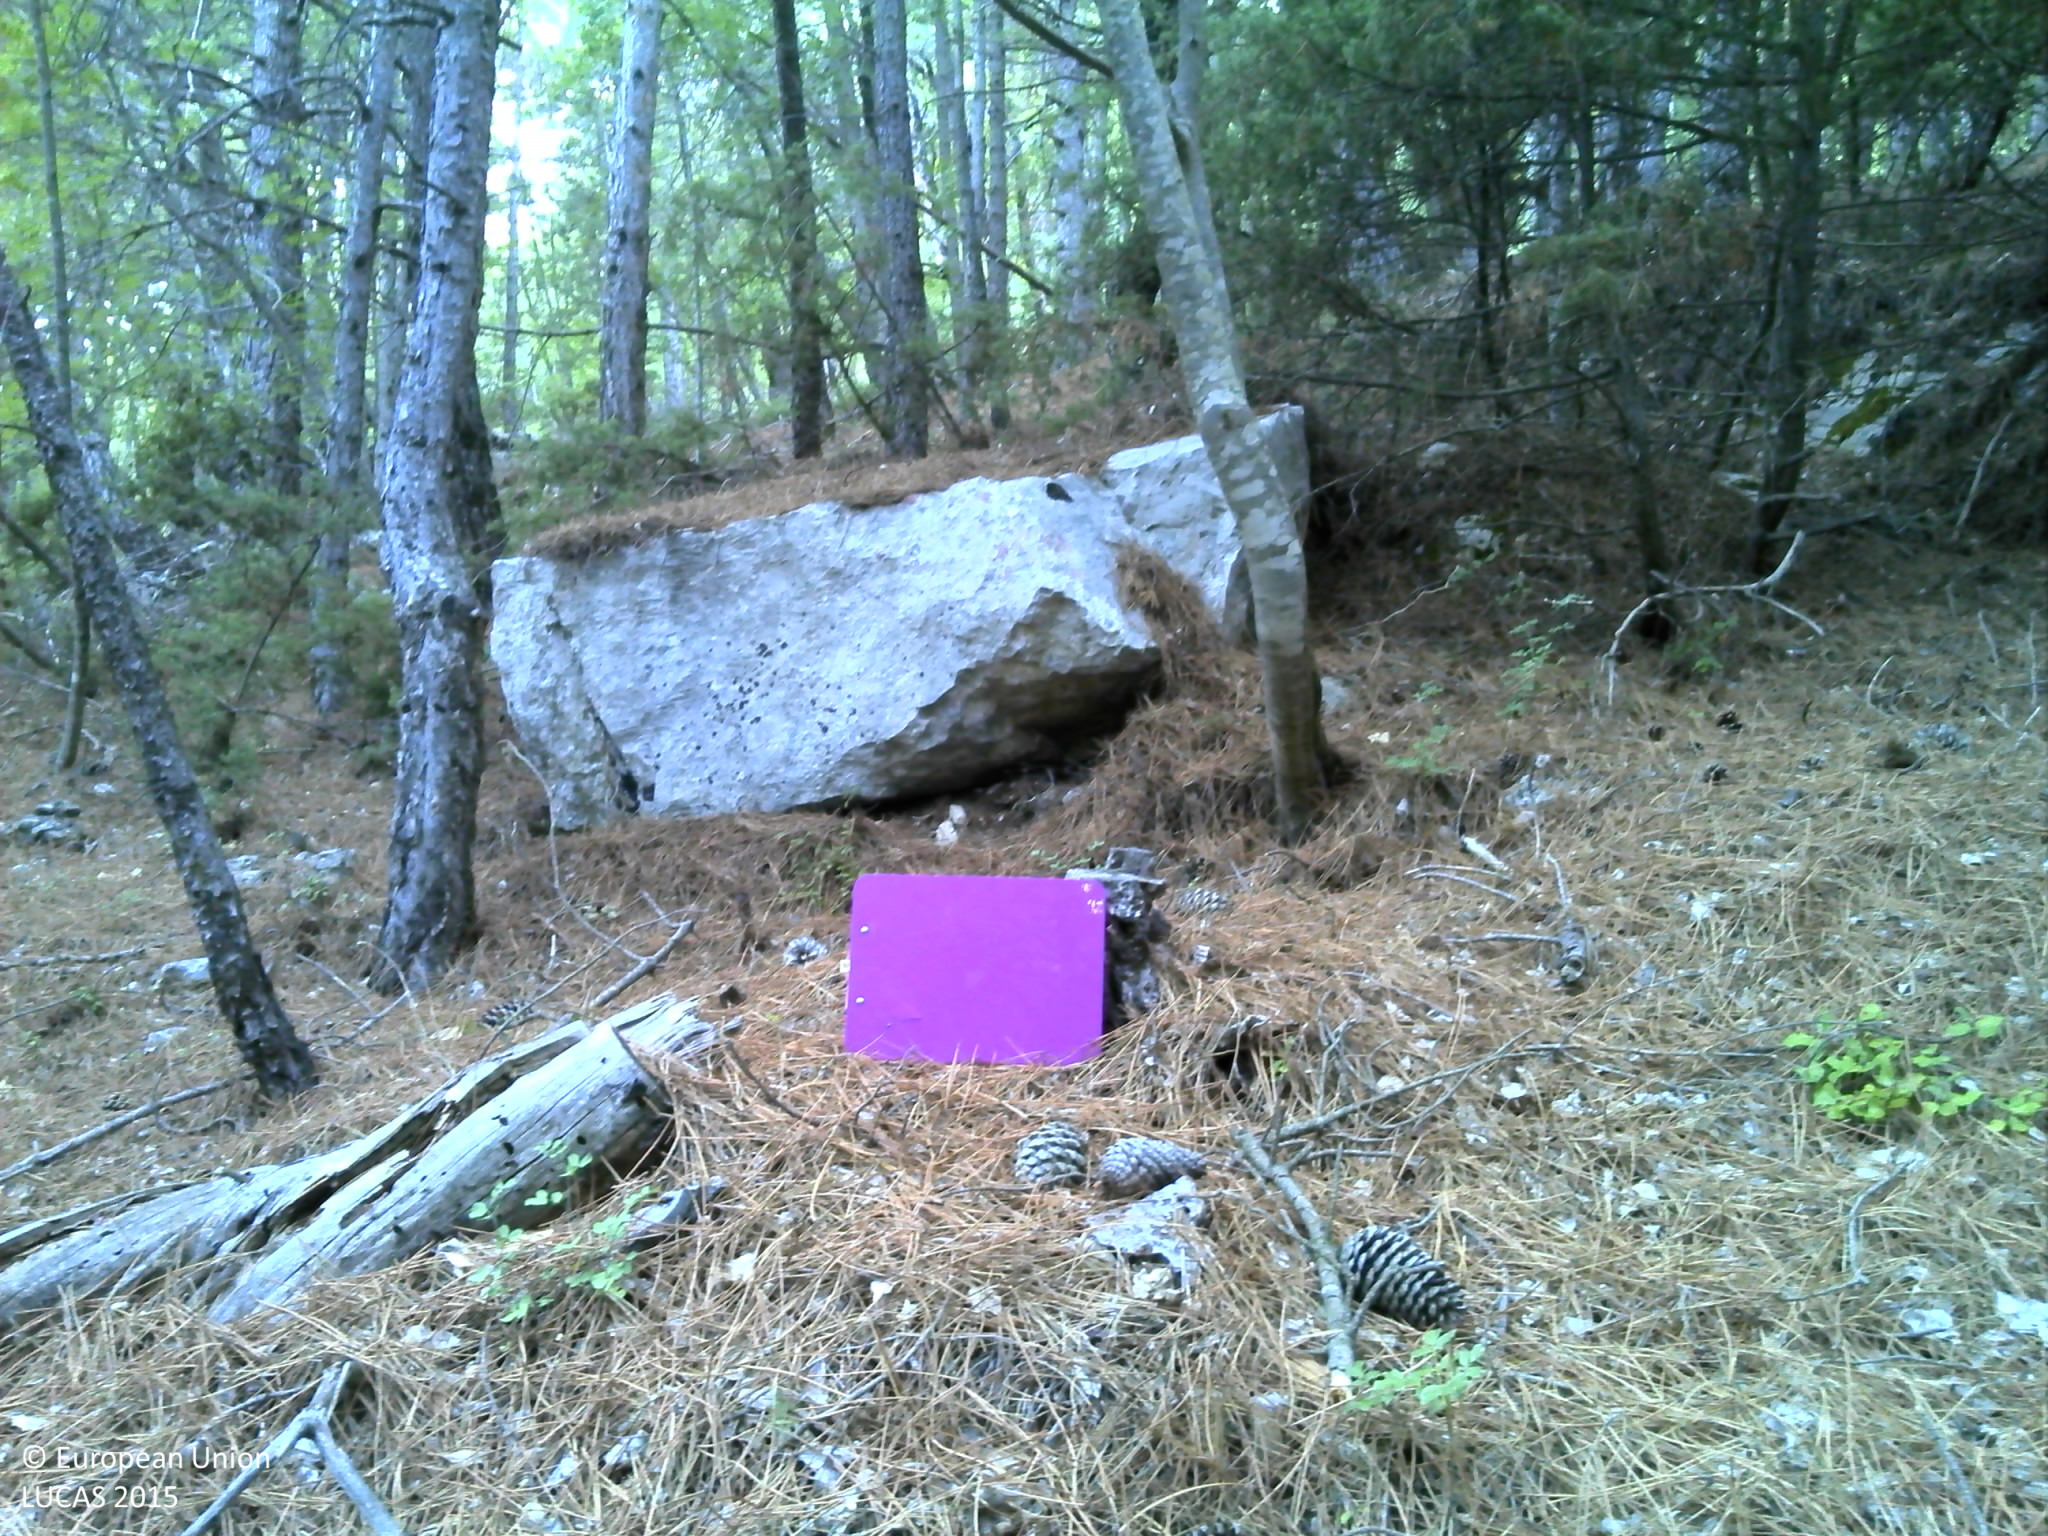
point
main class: Woodland
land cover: Pine dominated coniferous woodland
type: coniferous forest of the mediterranean region
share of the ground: > 75 %
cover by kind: coniferous forest trees 80 %, broadleaved forest trees 5 %, shrubs 5 %, consolidated bare surface 5 %, unconsolidated bare surface 5 %
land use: Semi-natural and natural areas not in use
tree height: > 5 m
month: August
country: HR
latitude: 43.2563
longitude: 17.0983
